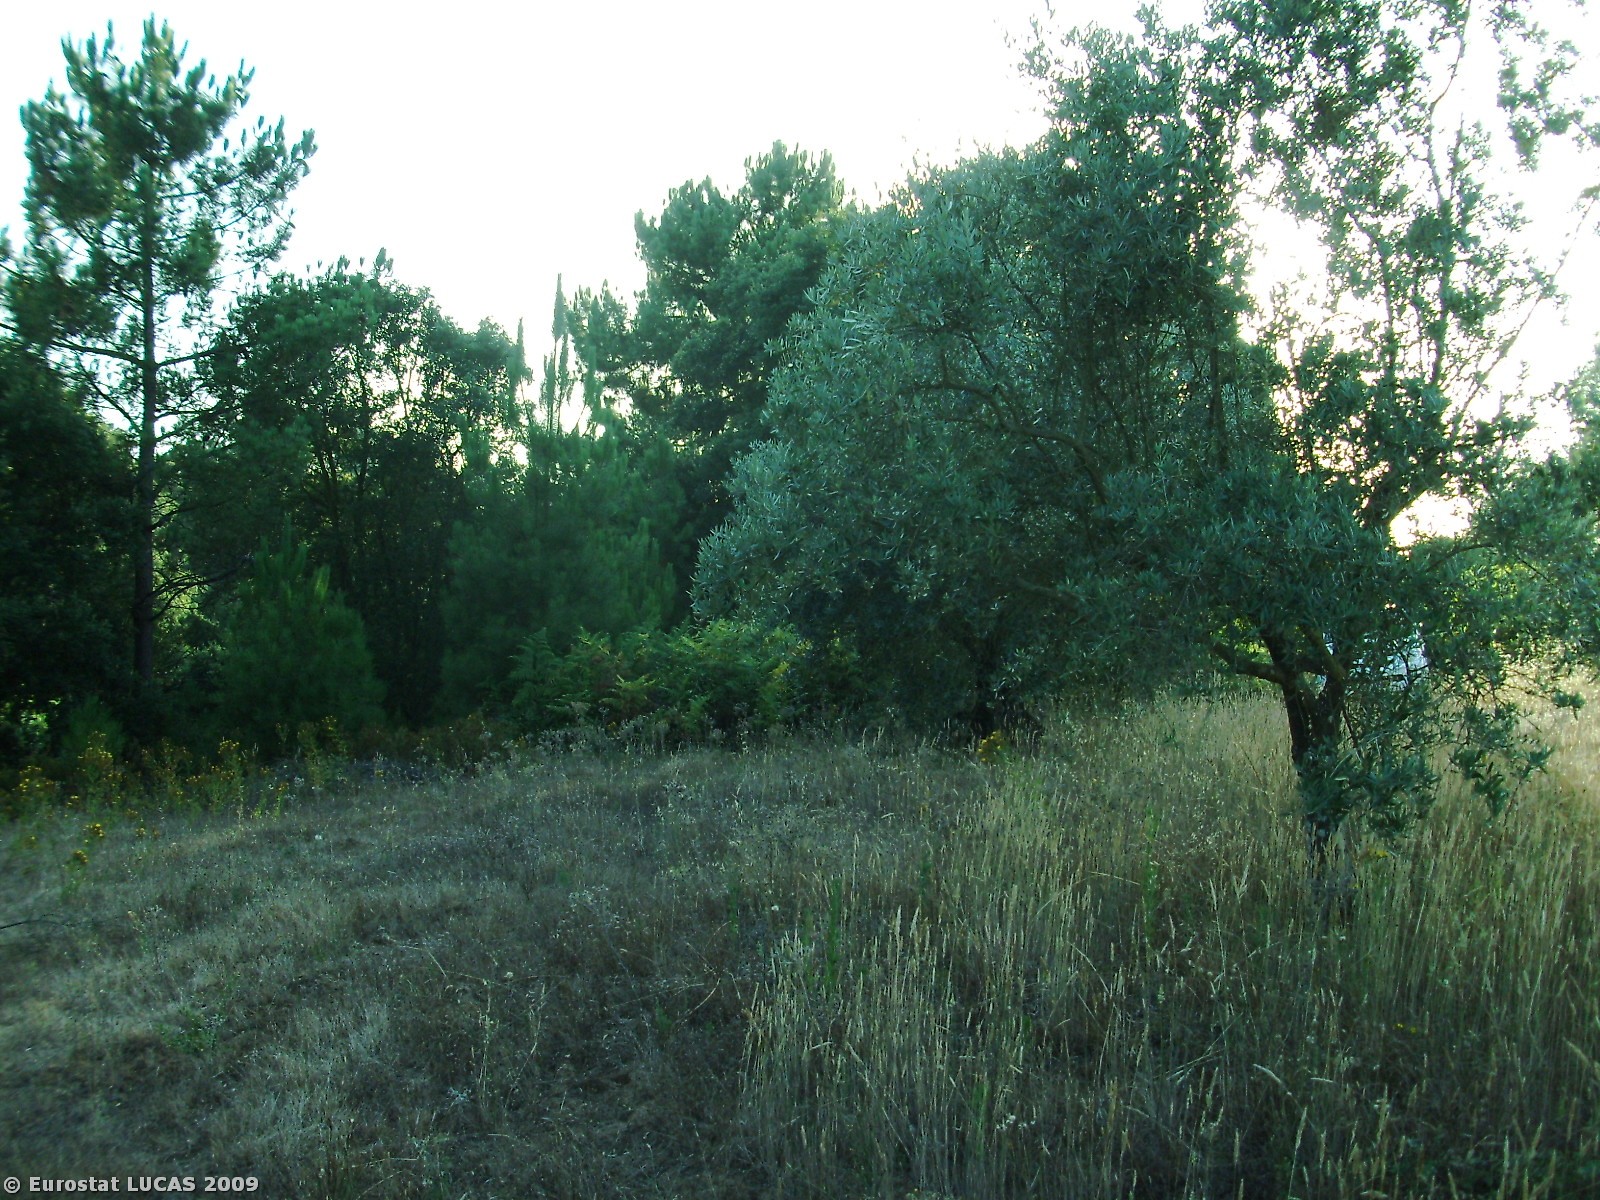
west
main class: Cropland
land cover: Olive groves
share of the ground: 25 - 50 %
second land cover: Spontaneously vegetated surfaces
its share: 50 - 75 %
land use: Agriculture (excluding fallow land and kitchen gardens)
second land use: Fallow land
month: July
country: PT
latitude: 39.3223
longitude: -8.8826
